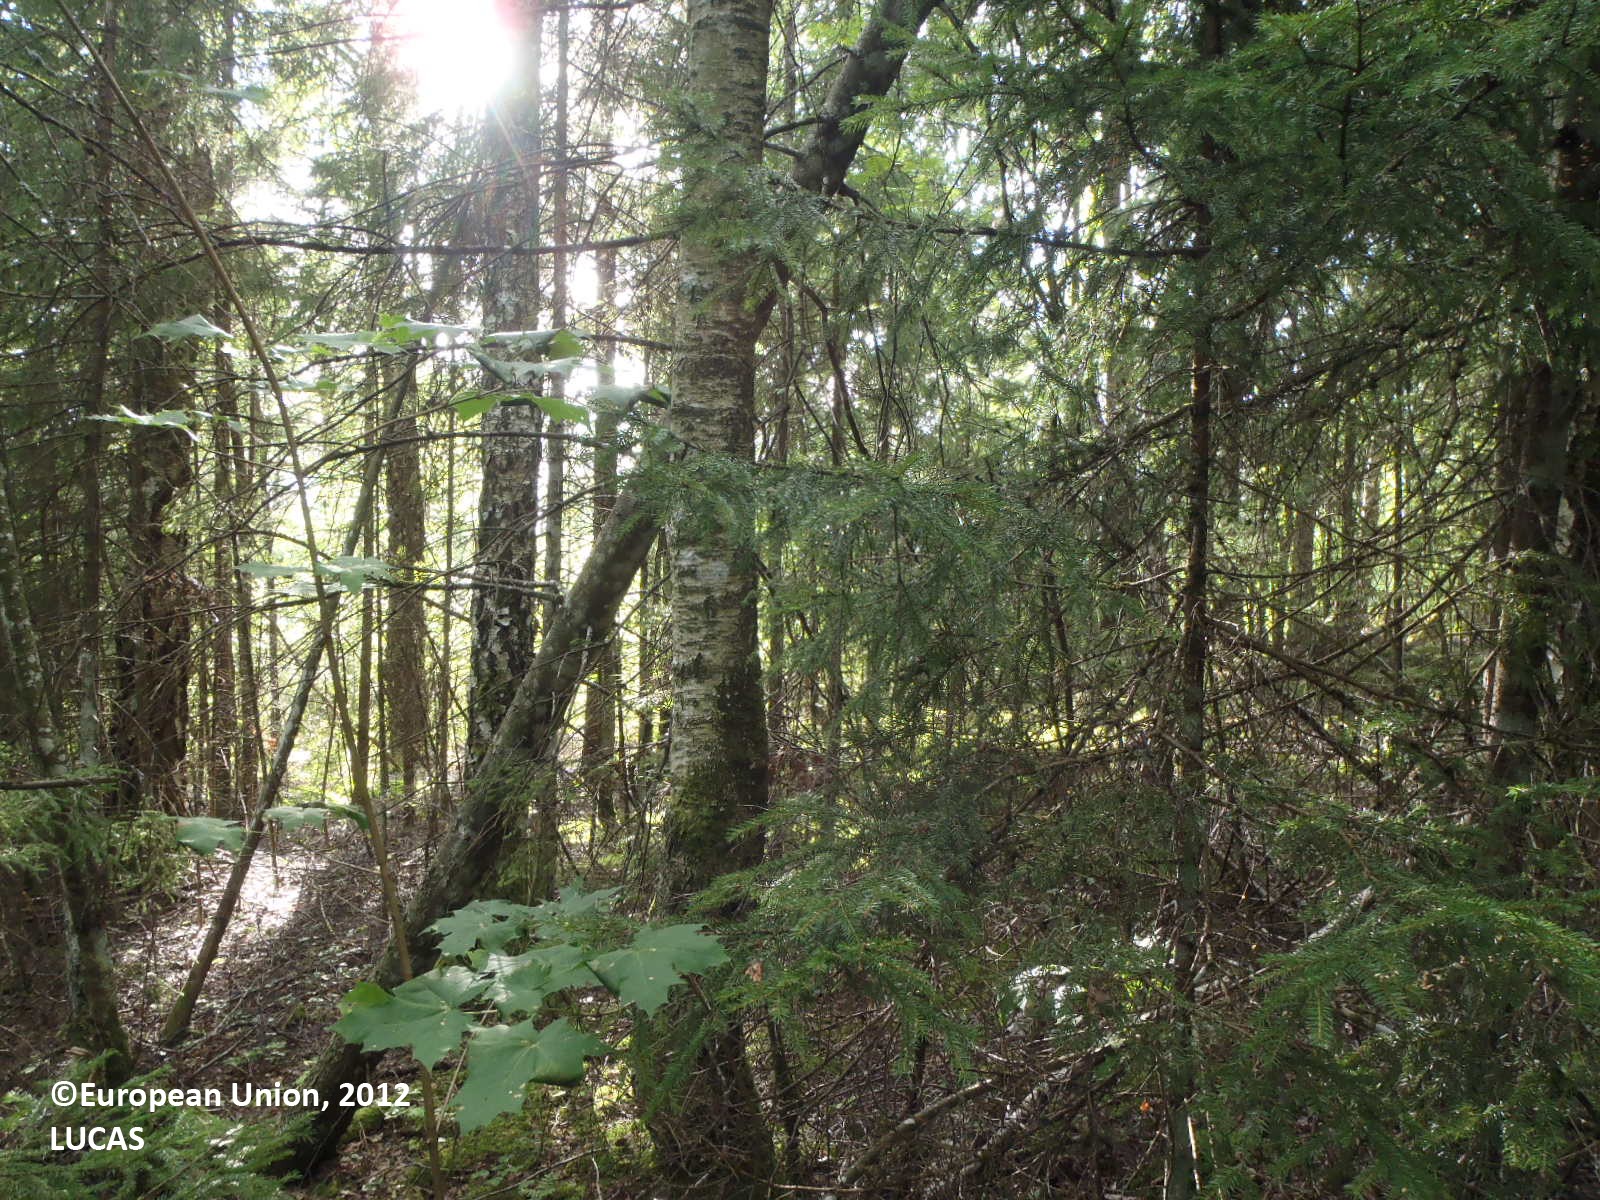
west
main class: Woodland
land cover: Spruce dominated mixed woodland
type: boreal forest
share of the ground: > 75 %
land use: Forestry
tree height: > 5 m
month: August
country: FI
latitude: 60.2955
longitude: 22.3169
